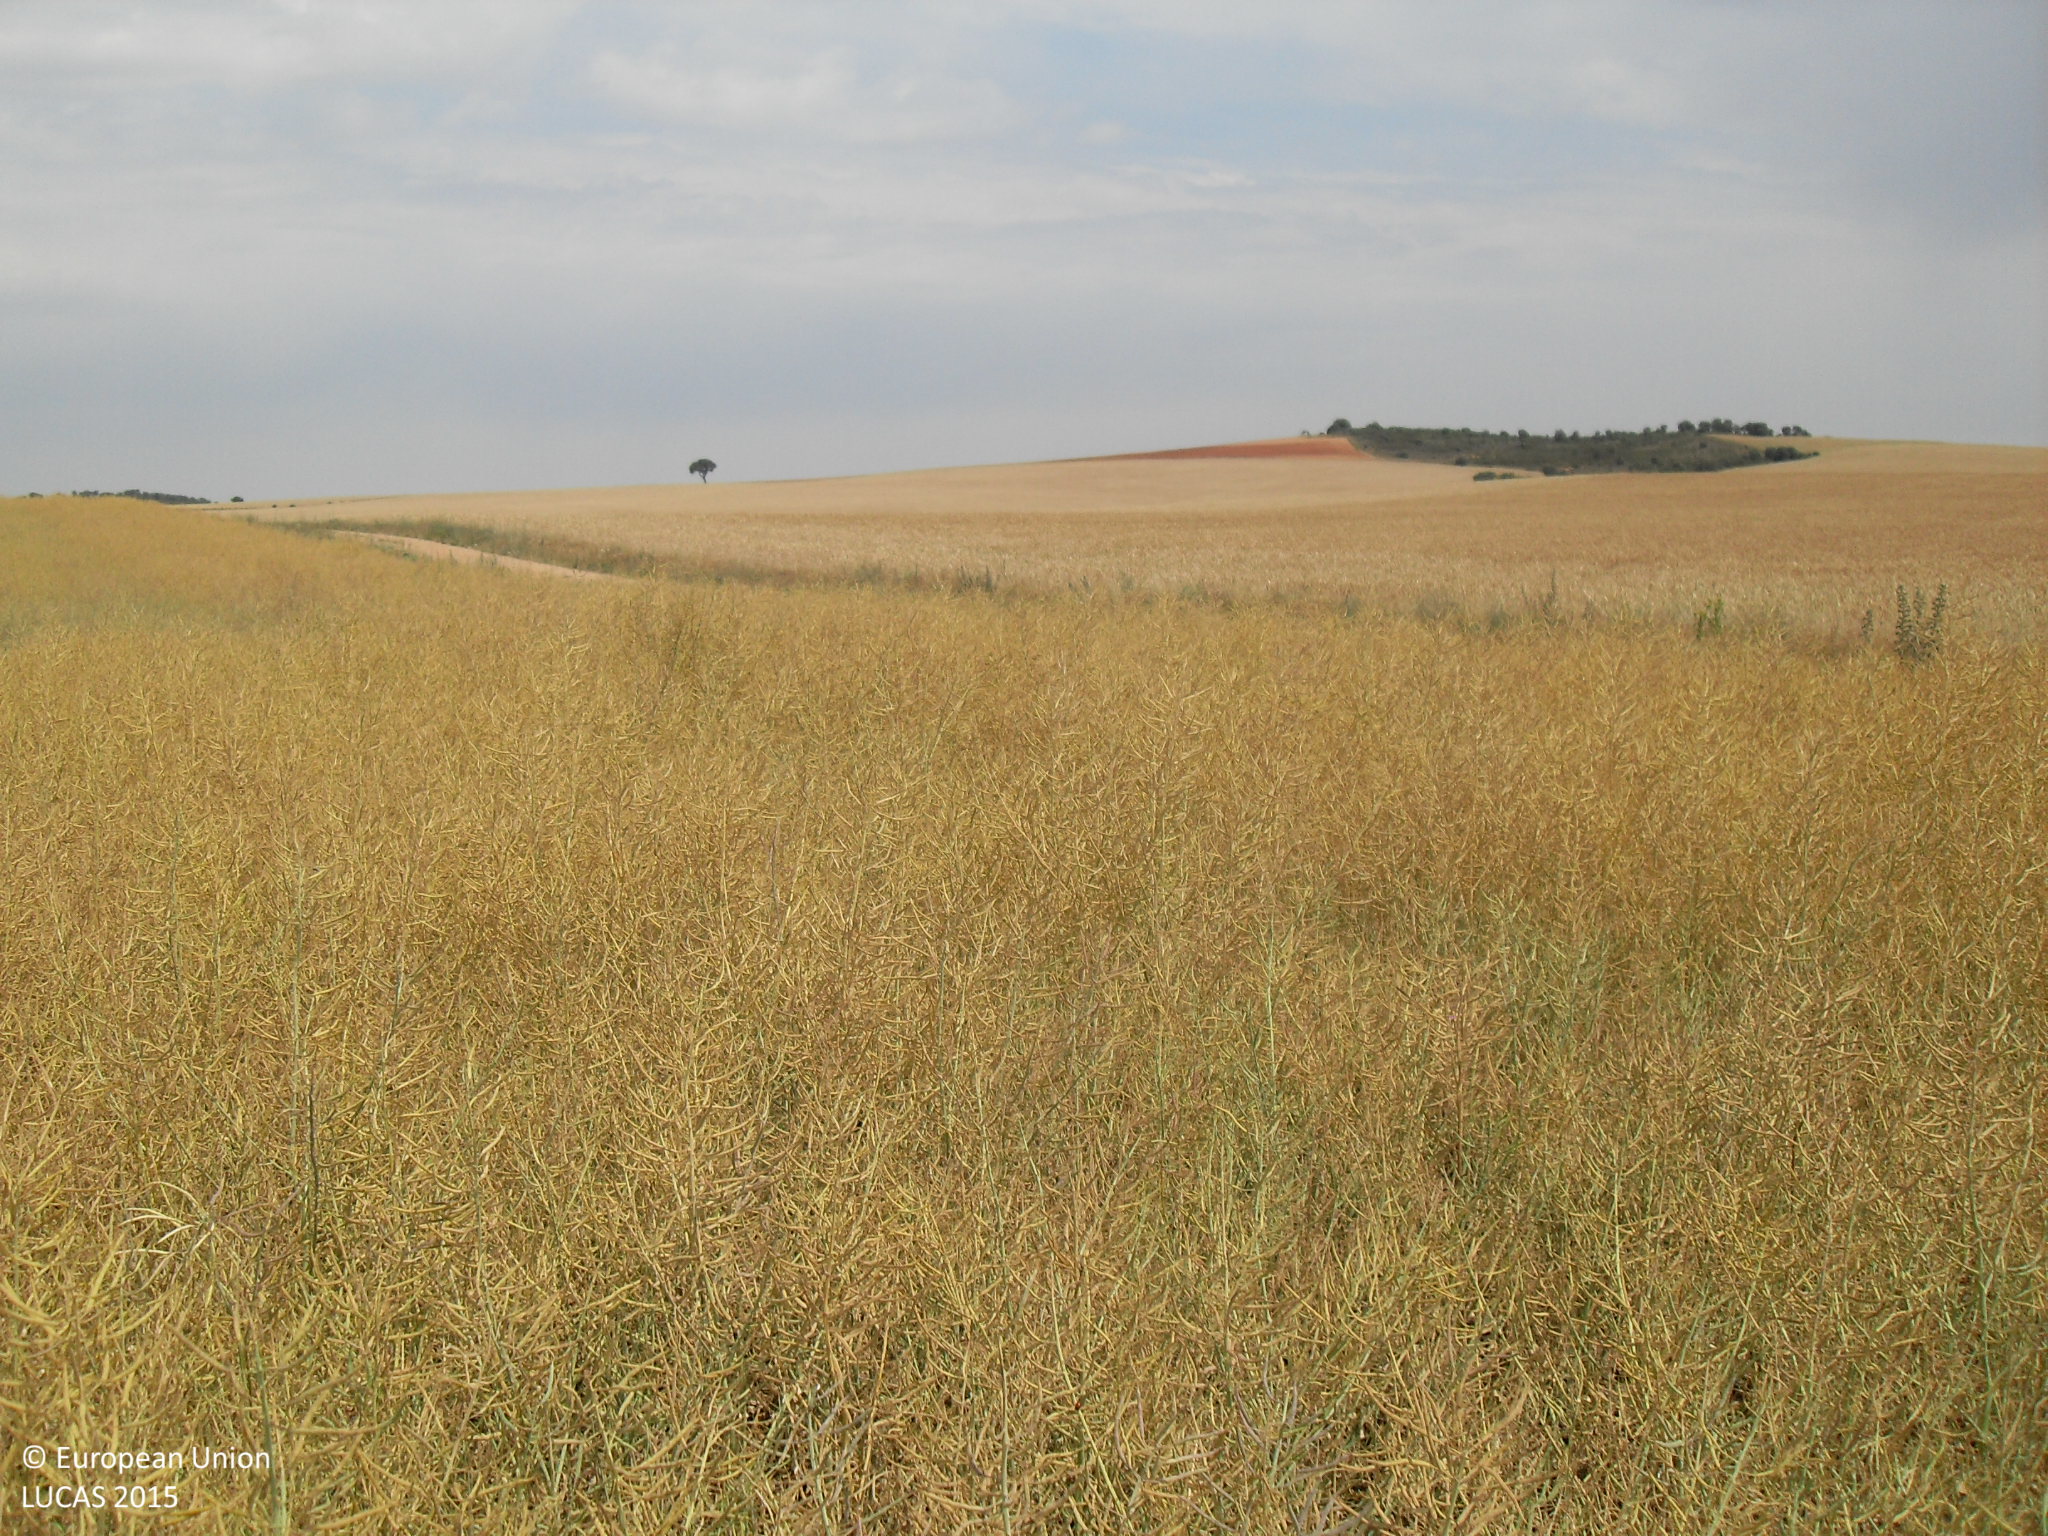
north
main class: Cropland
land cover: Rape and turnip rape
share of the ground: > 75 %
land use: Agriculture (excluding fallow land and kitchen gardens)
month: June
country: ES
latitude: 41.1682
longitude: -5.4391
